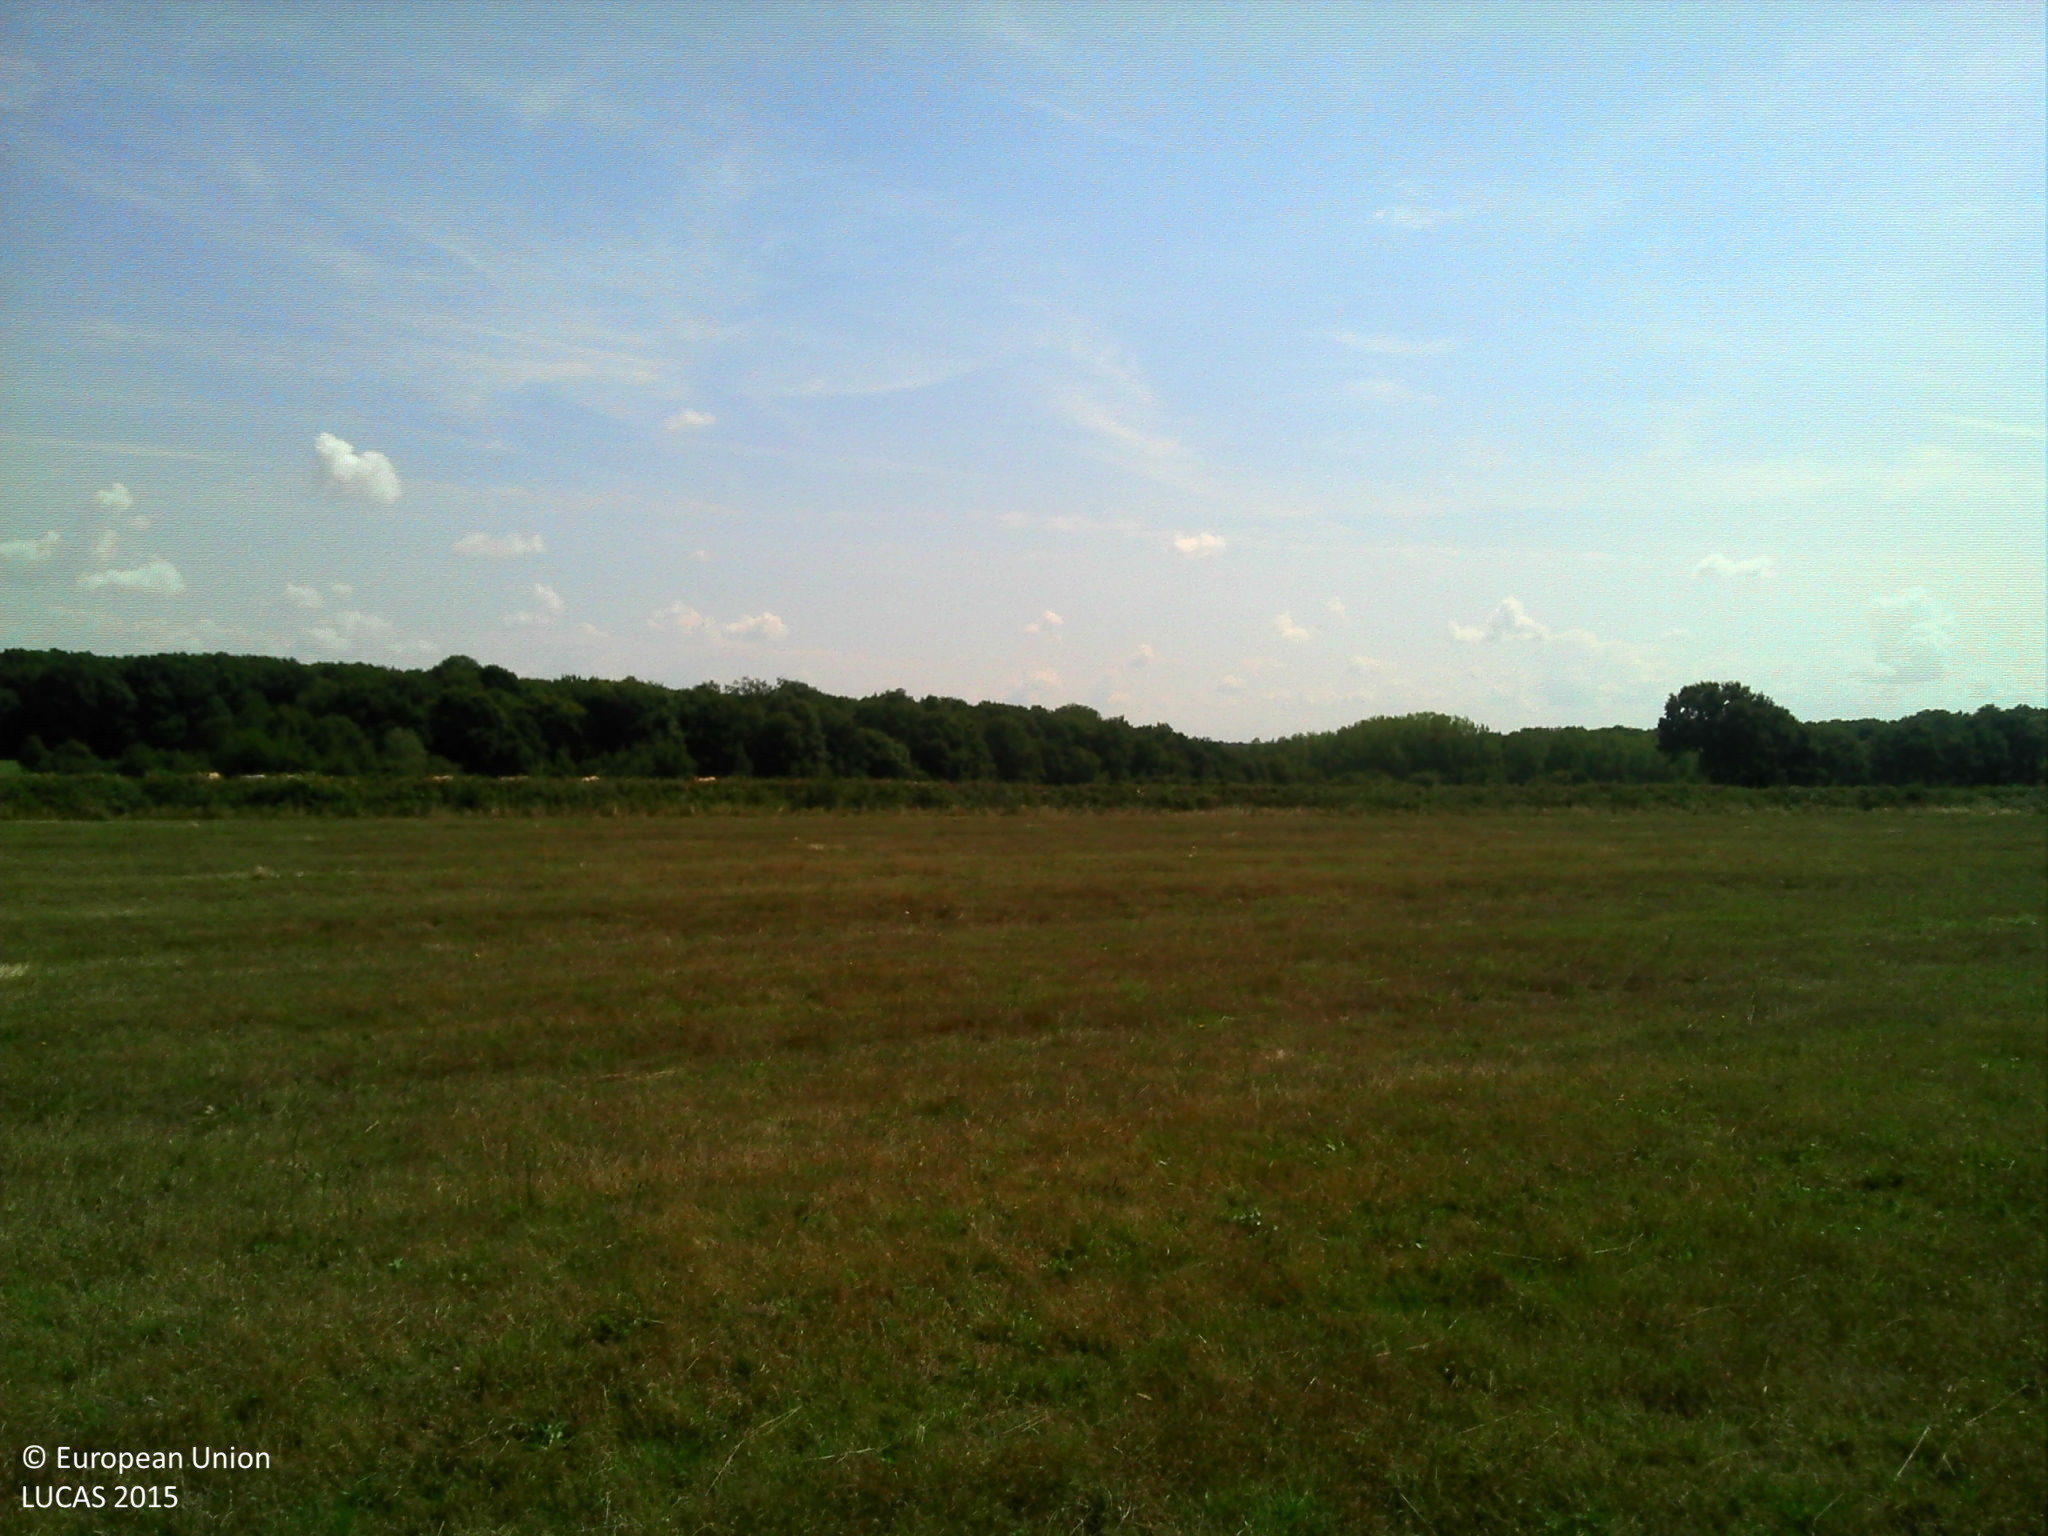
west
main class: Grassland
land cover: Grassland without tree/shrub cover
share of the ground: > 75 %
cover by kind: herbaceous plants 100 %
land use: Agriculture (excluding fallow land and kitchen gardens)
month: August
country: FR
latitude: 46.5359
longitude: 3.2569
